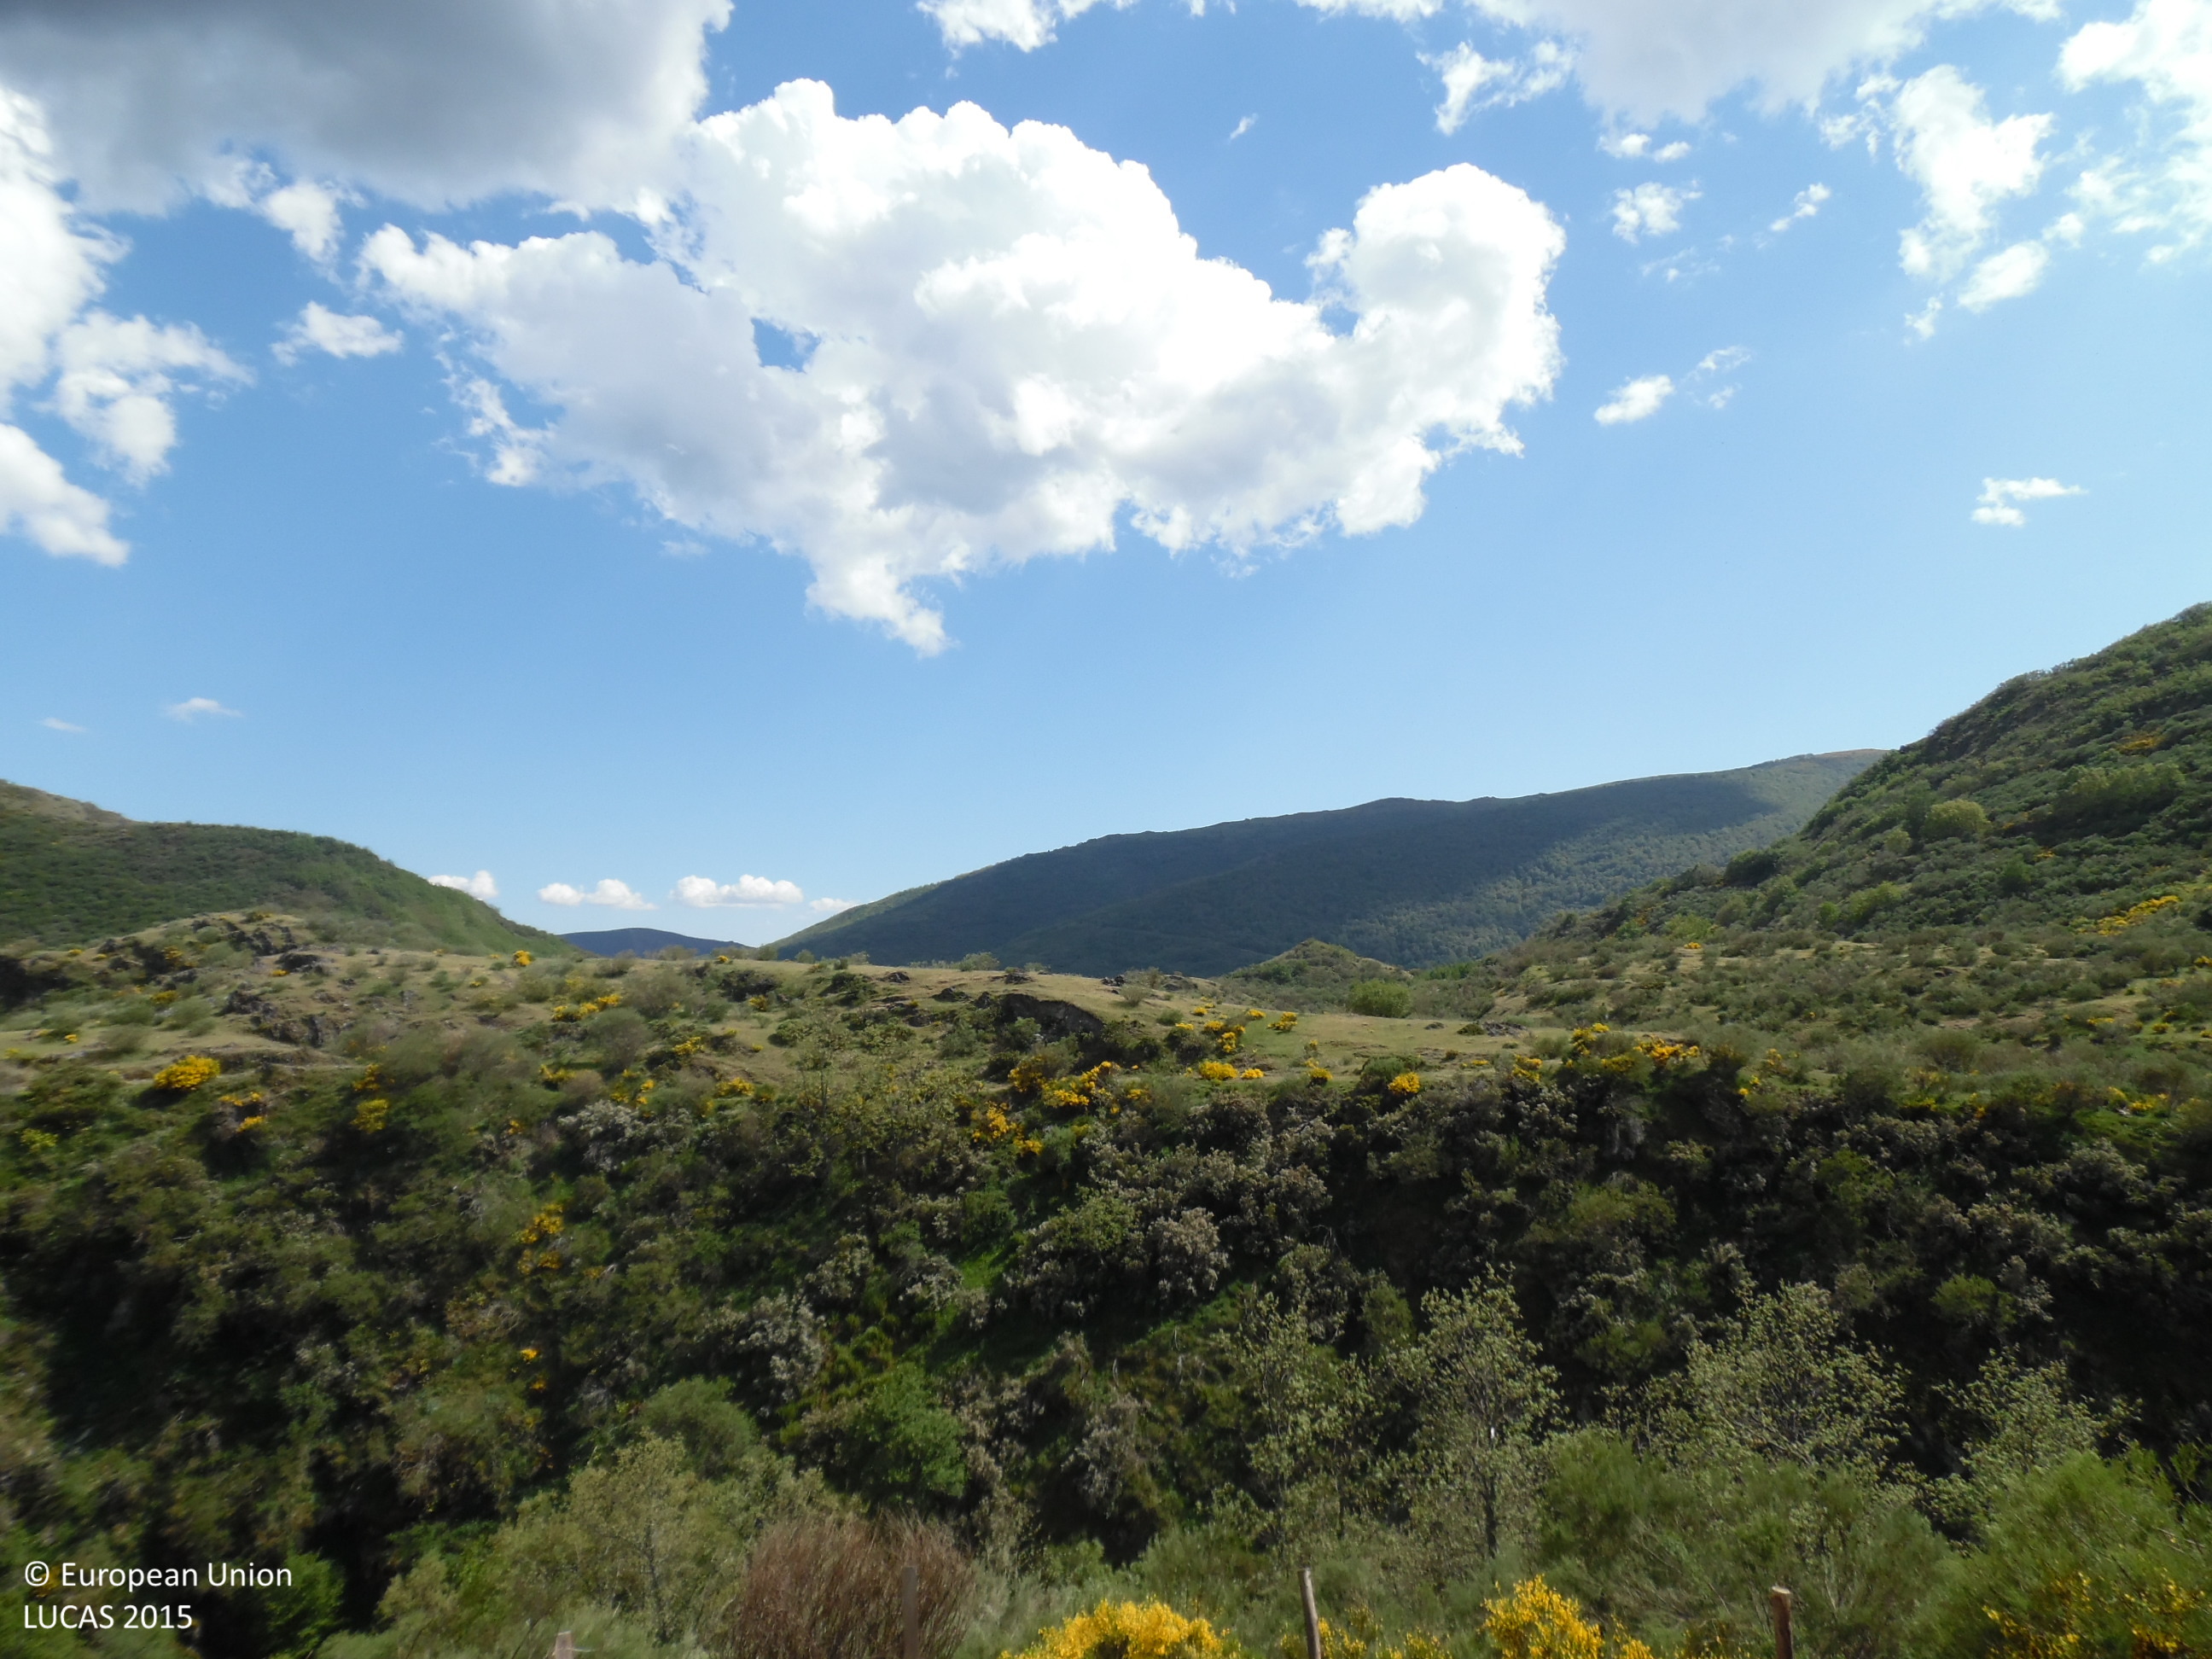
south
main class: Shrubland
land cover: Shrubland without tree cover
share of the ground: > 75 %
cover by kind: shrubs 100 %
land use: Semi-natural and natural areas not in use
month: May
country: ES
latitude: 42.8890
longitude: -6.1667
